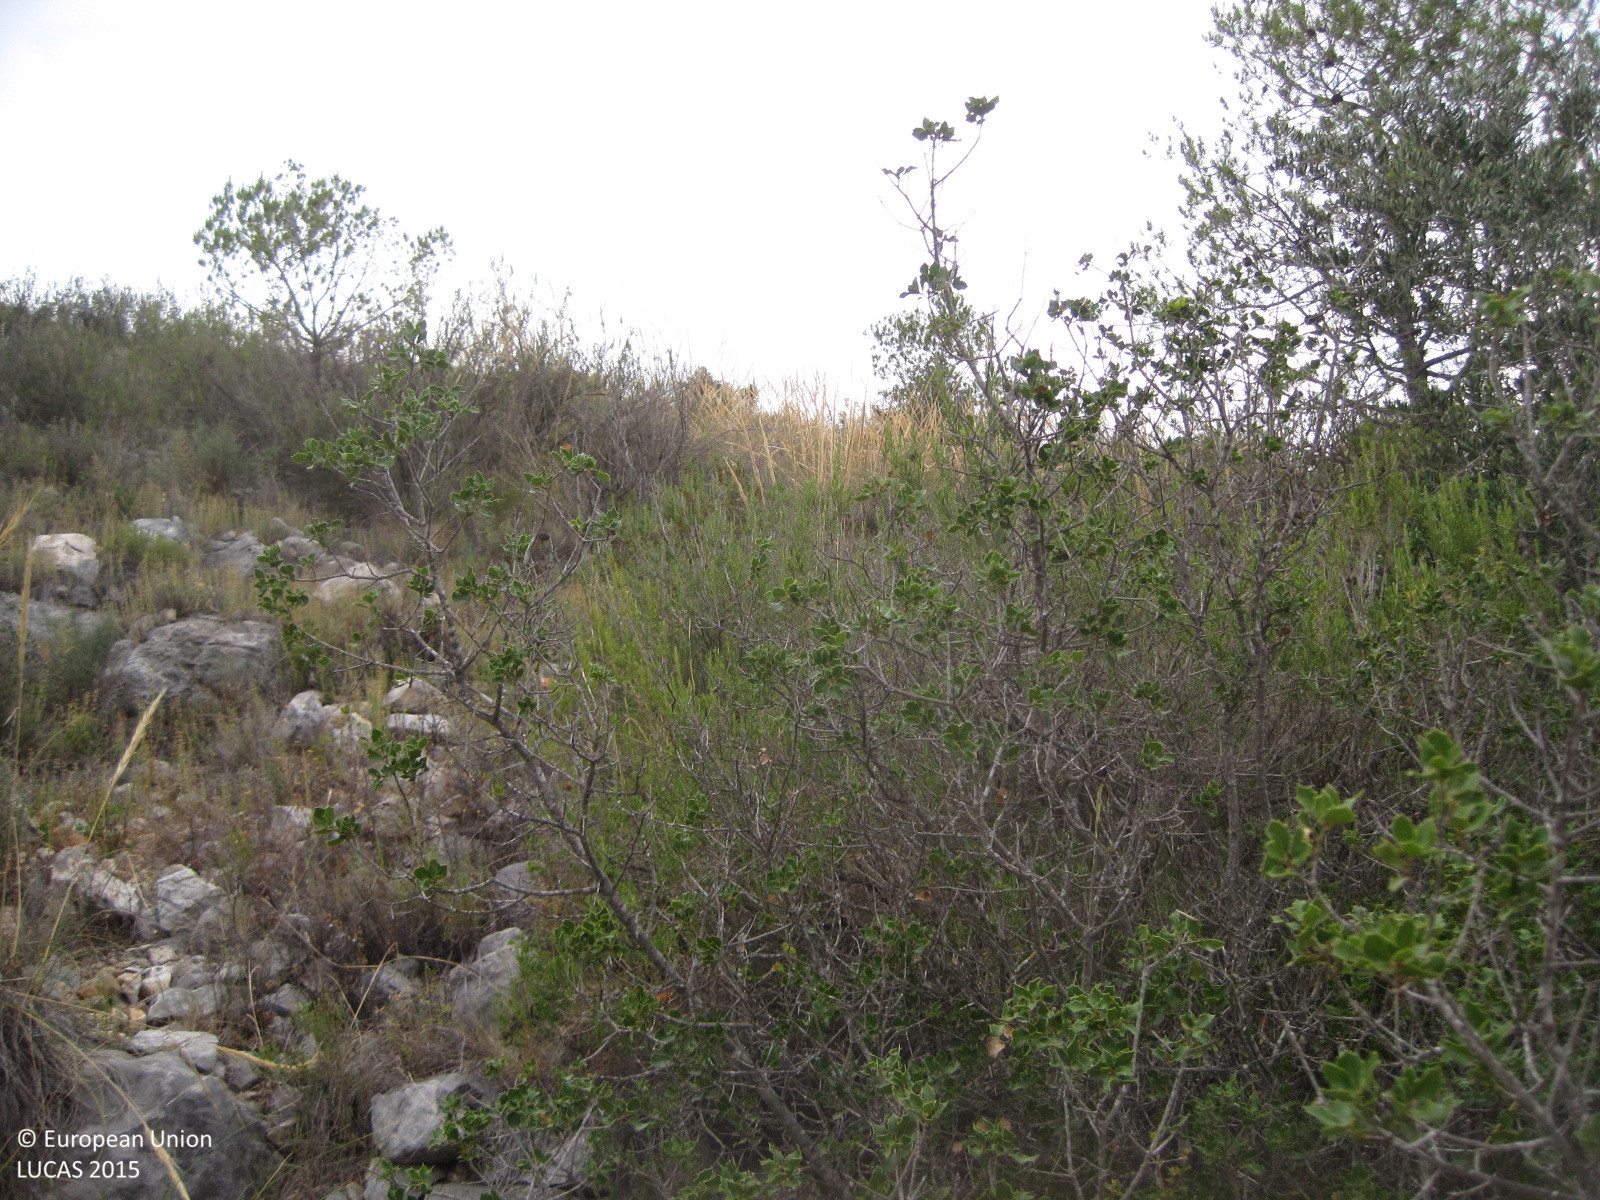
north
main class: Woodland
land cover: Pine dominated coniferous woodland
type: coniferous forest of the mediterranean region
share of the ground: 10 - 25 %
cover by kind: shrubs 30 %, herbaceous plants 30 %, coniferous forest trees 20 %, consolidated bare surface 20 %
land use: Semi-natural and natural areas not in use
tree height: > 5 m
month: June
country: ES
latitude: 39.3125
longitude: -0.5621
